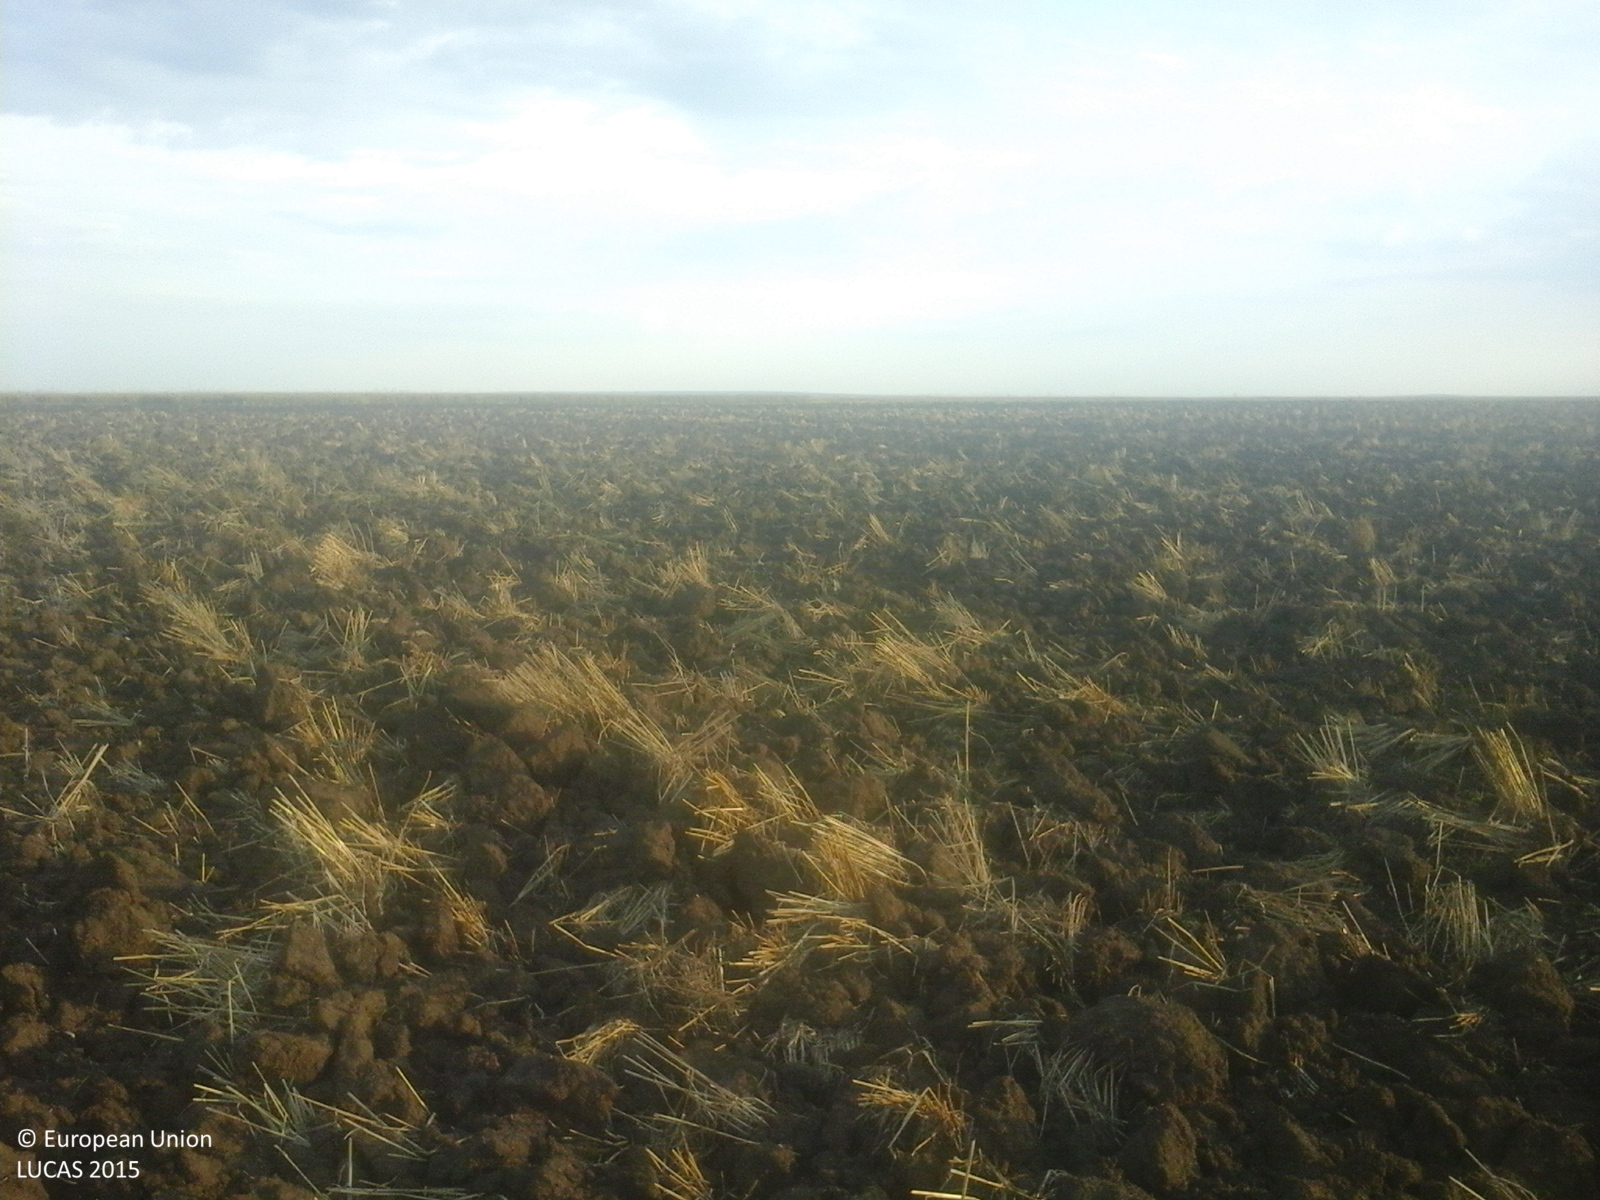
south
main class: Cropland
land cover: Common wheat
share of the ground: < 10 %
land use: Agriculture (excluding fallow land and kitchen gardens)
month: July
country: RO
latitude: 43.8341
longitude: 24.5288
